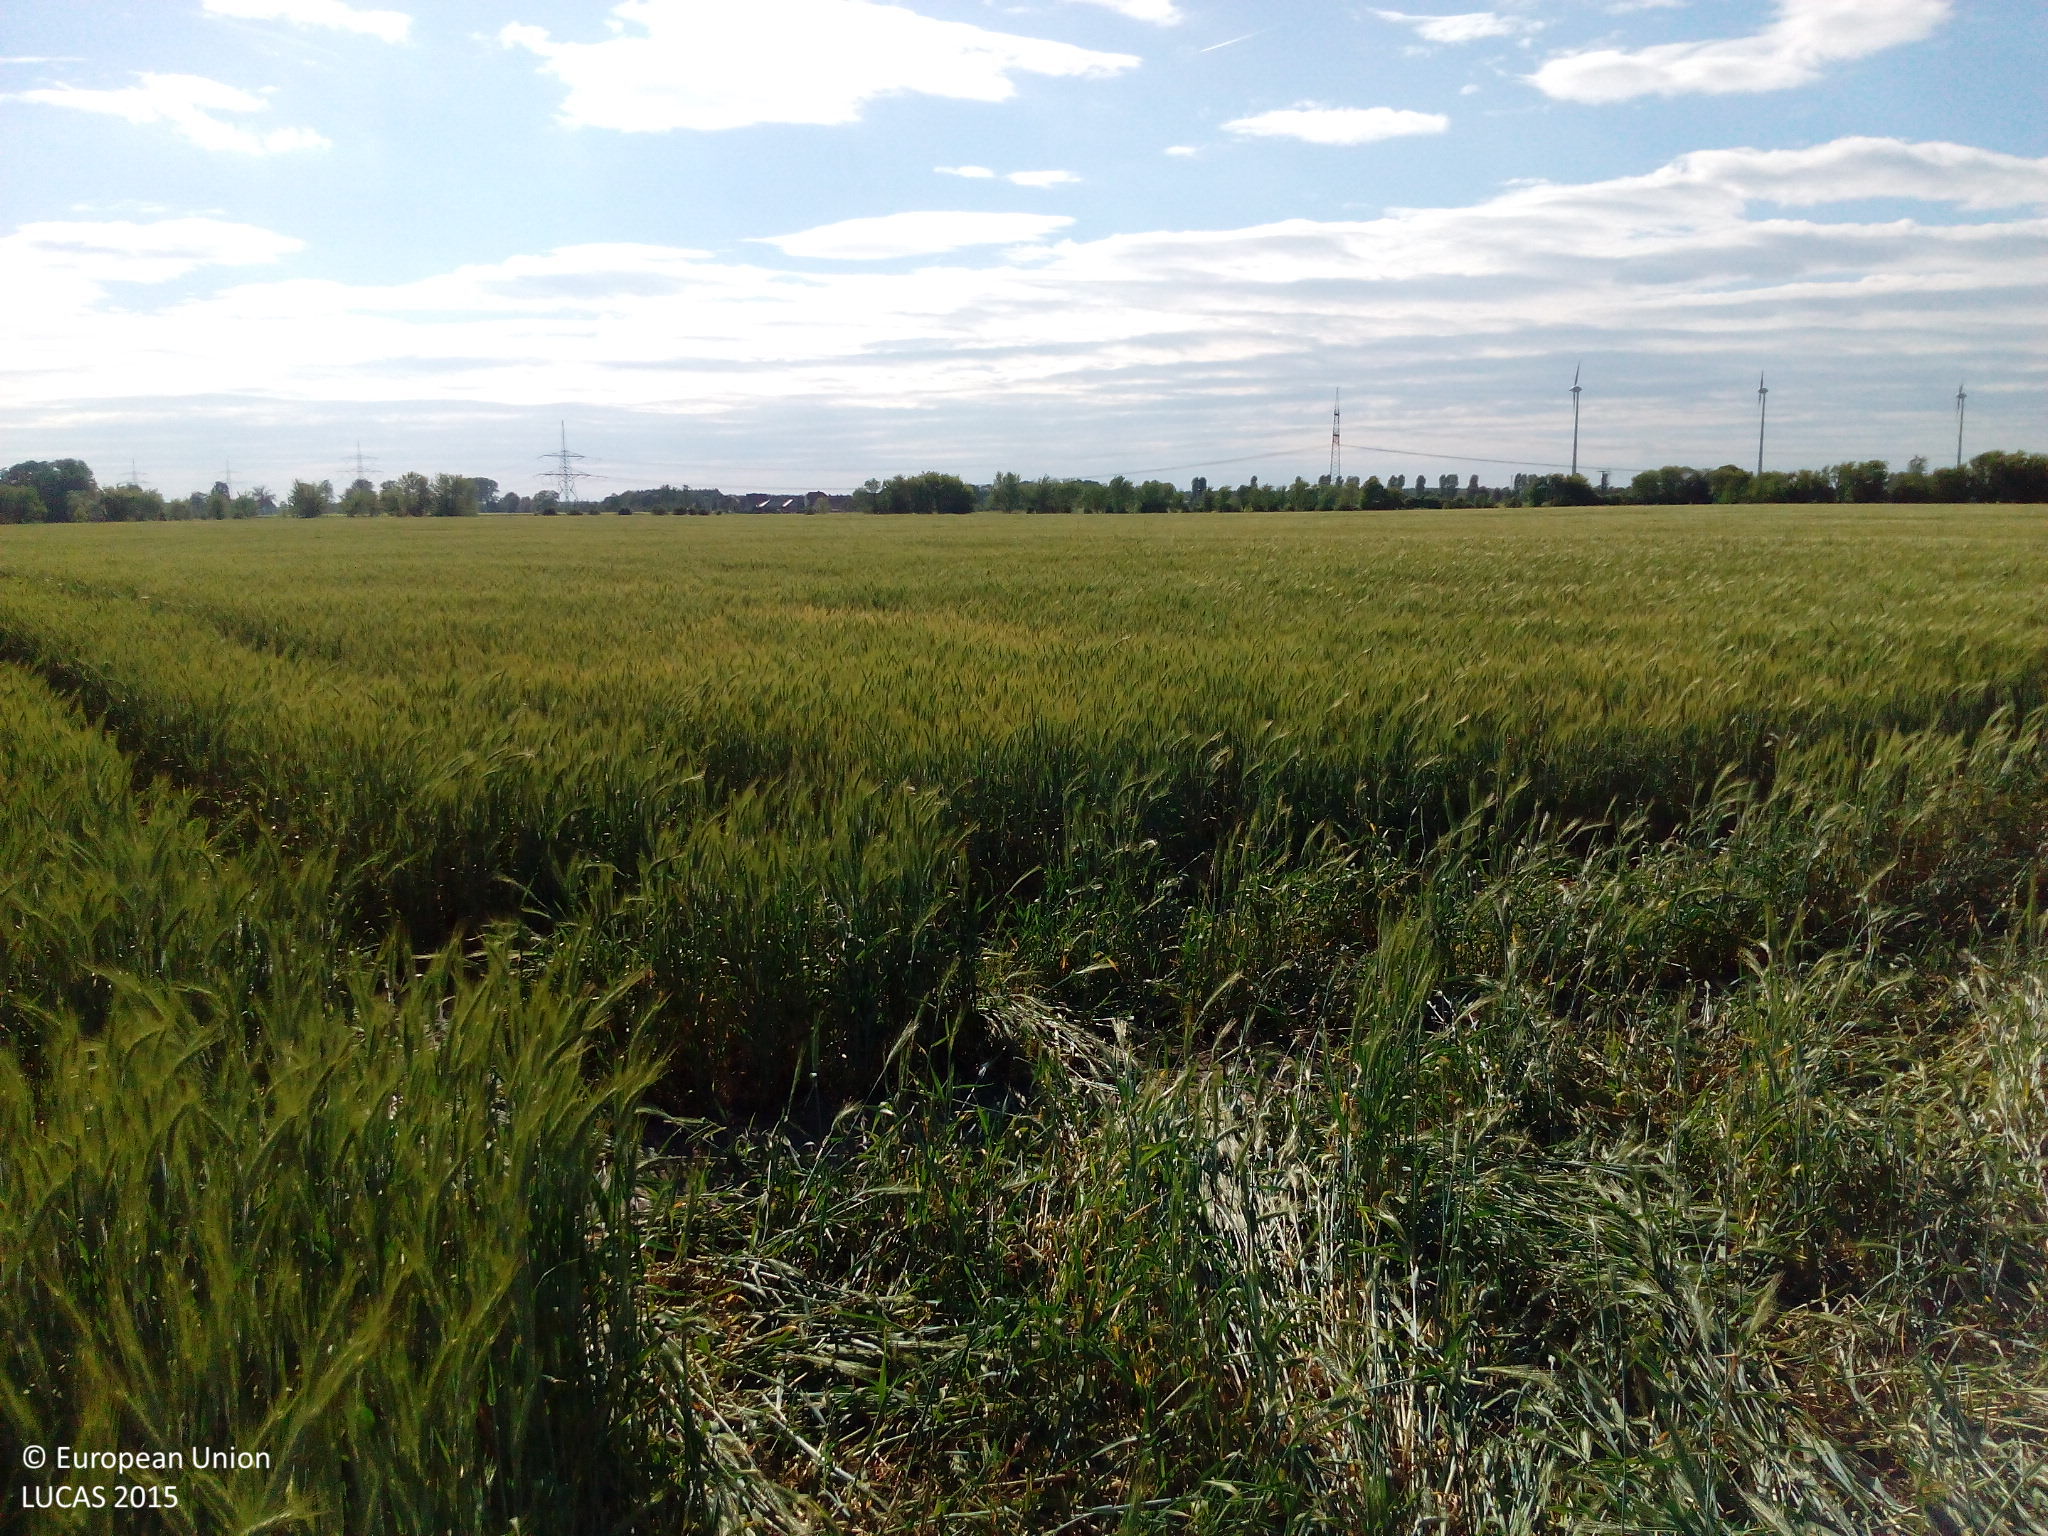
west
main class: Cropland
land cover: Triticale
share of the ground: > 75 %
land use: Agriculture (excluding fallow land and kitchen gardens)
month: June
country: DE
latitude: 51.4076
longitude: 13.5227
